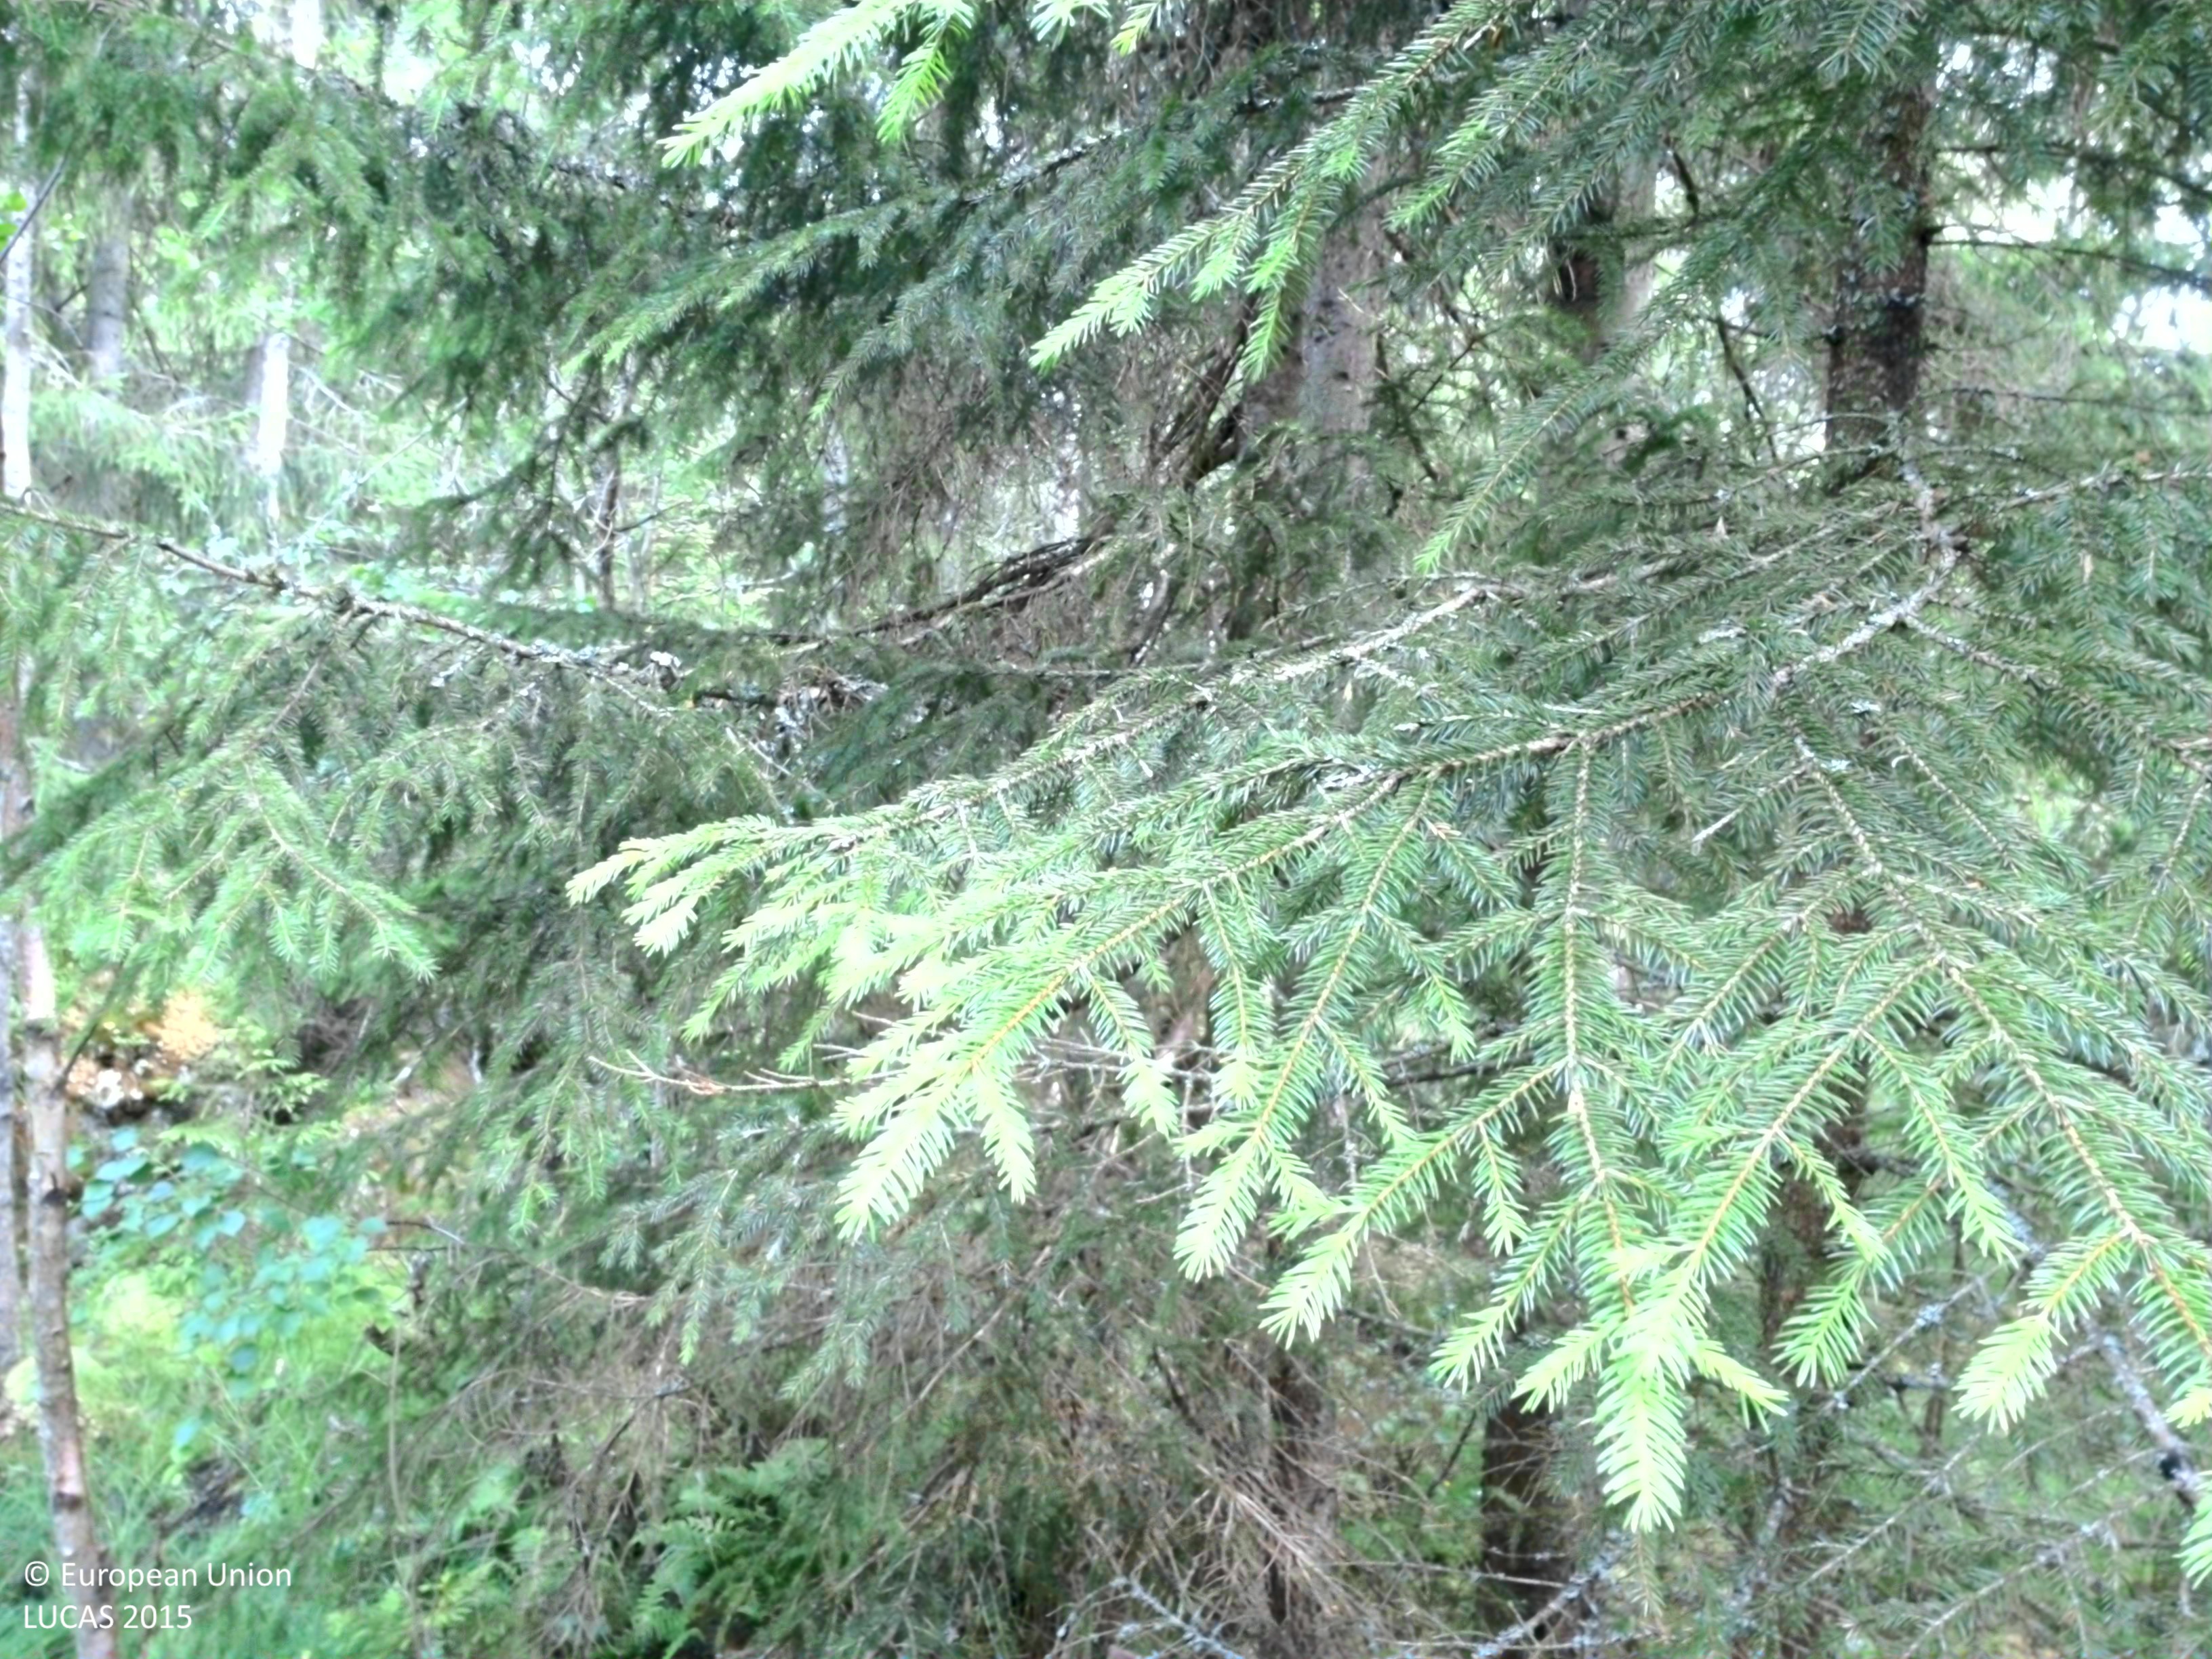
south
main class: Woodland
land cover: Spruce dominated coniferous woodland
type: boreal forest
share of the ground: > 75 %
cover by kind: coniferous forest trees 70 %, lichens and mosses 15 %, herbaceous plants 10 %, broadleaved forest trees 5 %
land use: Forestry
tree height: > 5 m
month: July
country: SE
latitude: 57.6252
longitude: 14.3992
